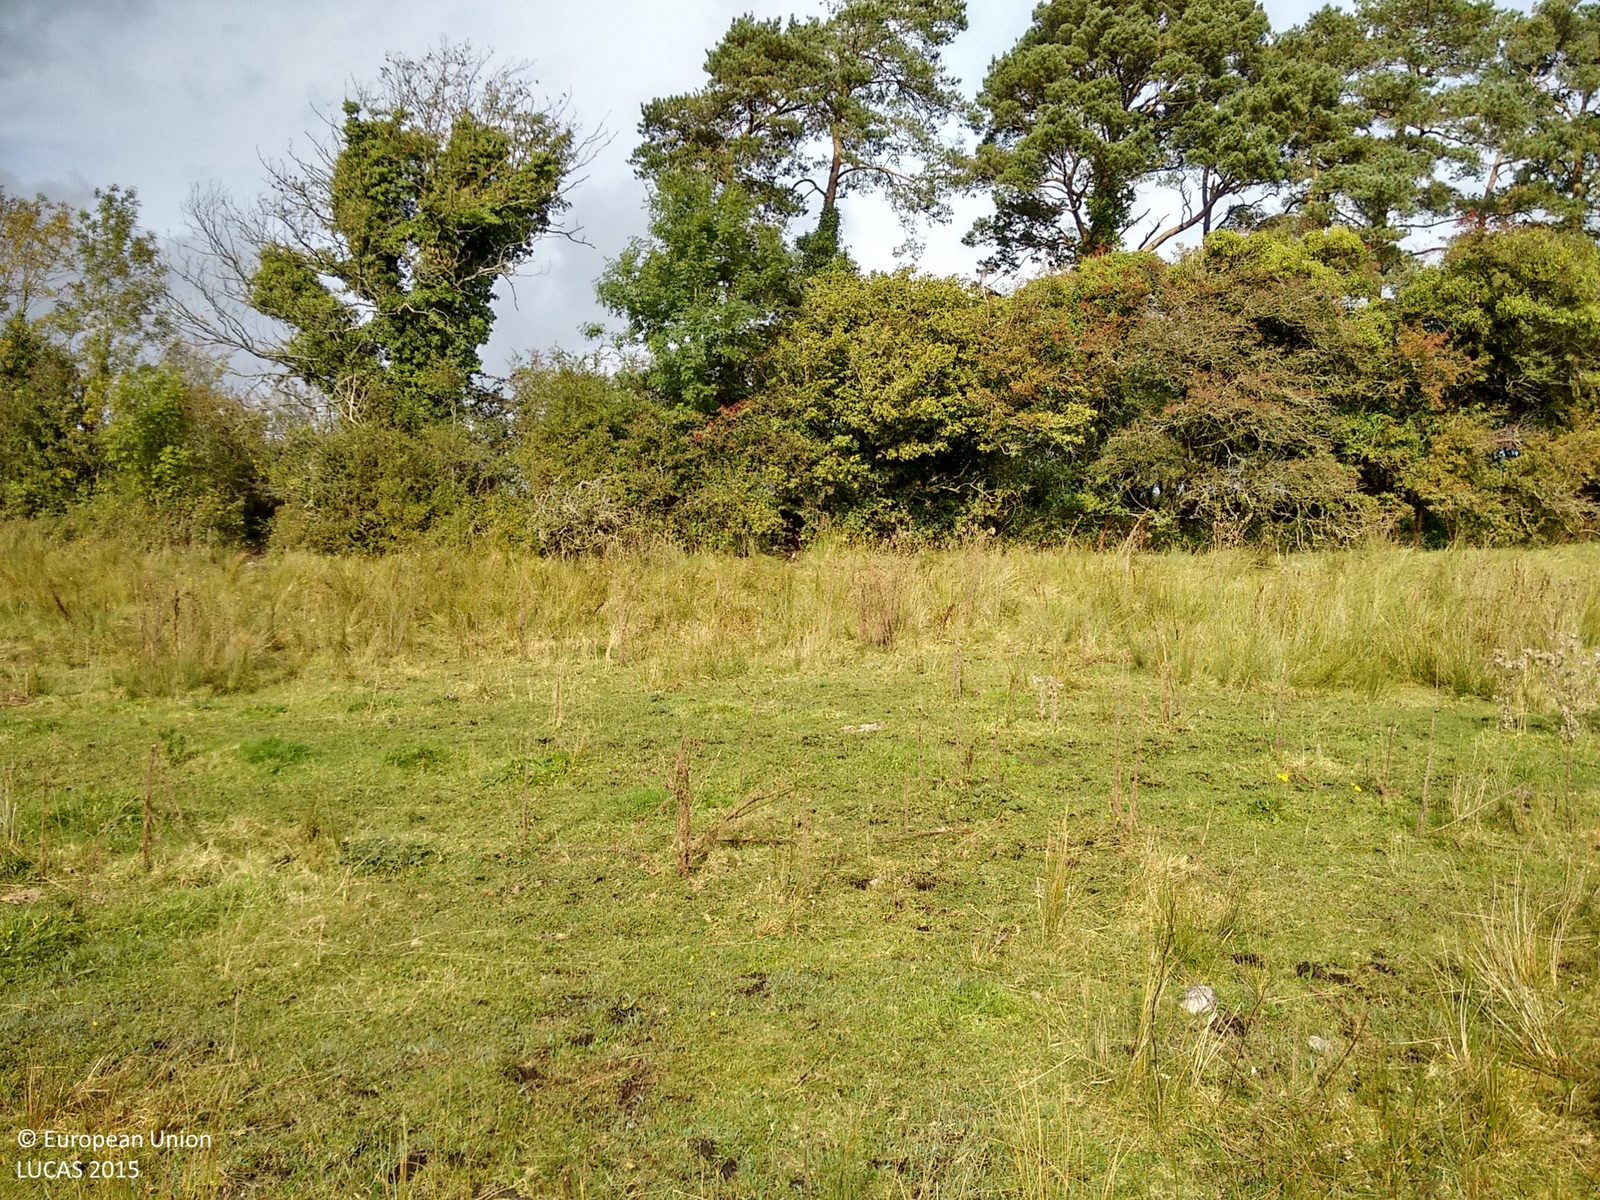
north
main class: Grassland
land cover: Grassland without tree/shrub cover
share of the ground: > 75 %
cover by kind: herbaceous plants 100 %
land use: Agriculture (excluding fallow land and kitchen gardens)
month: October
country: IE
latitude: 53.8179
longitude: -8.1805
